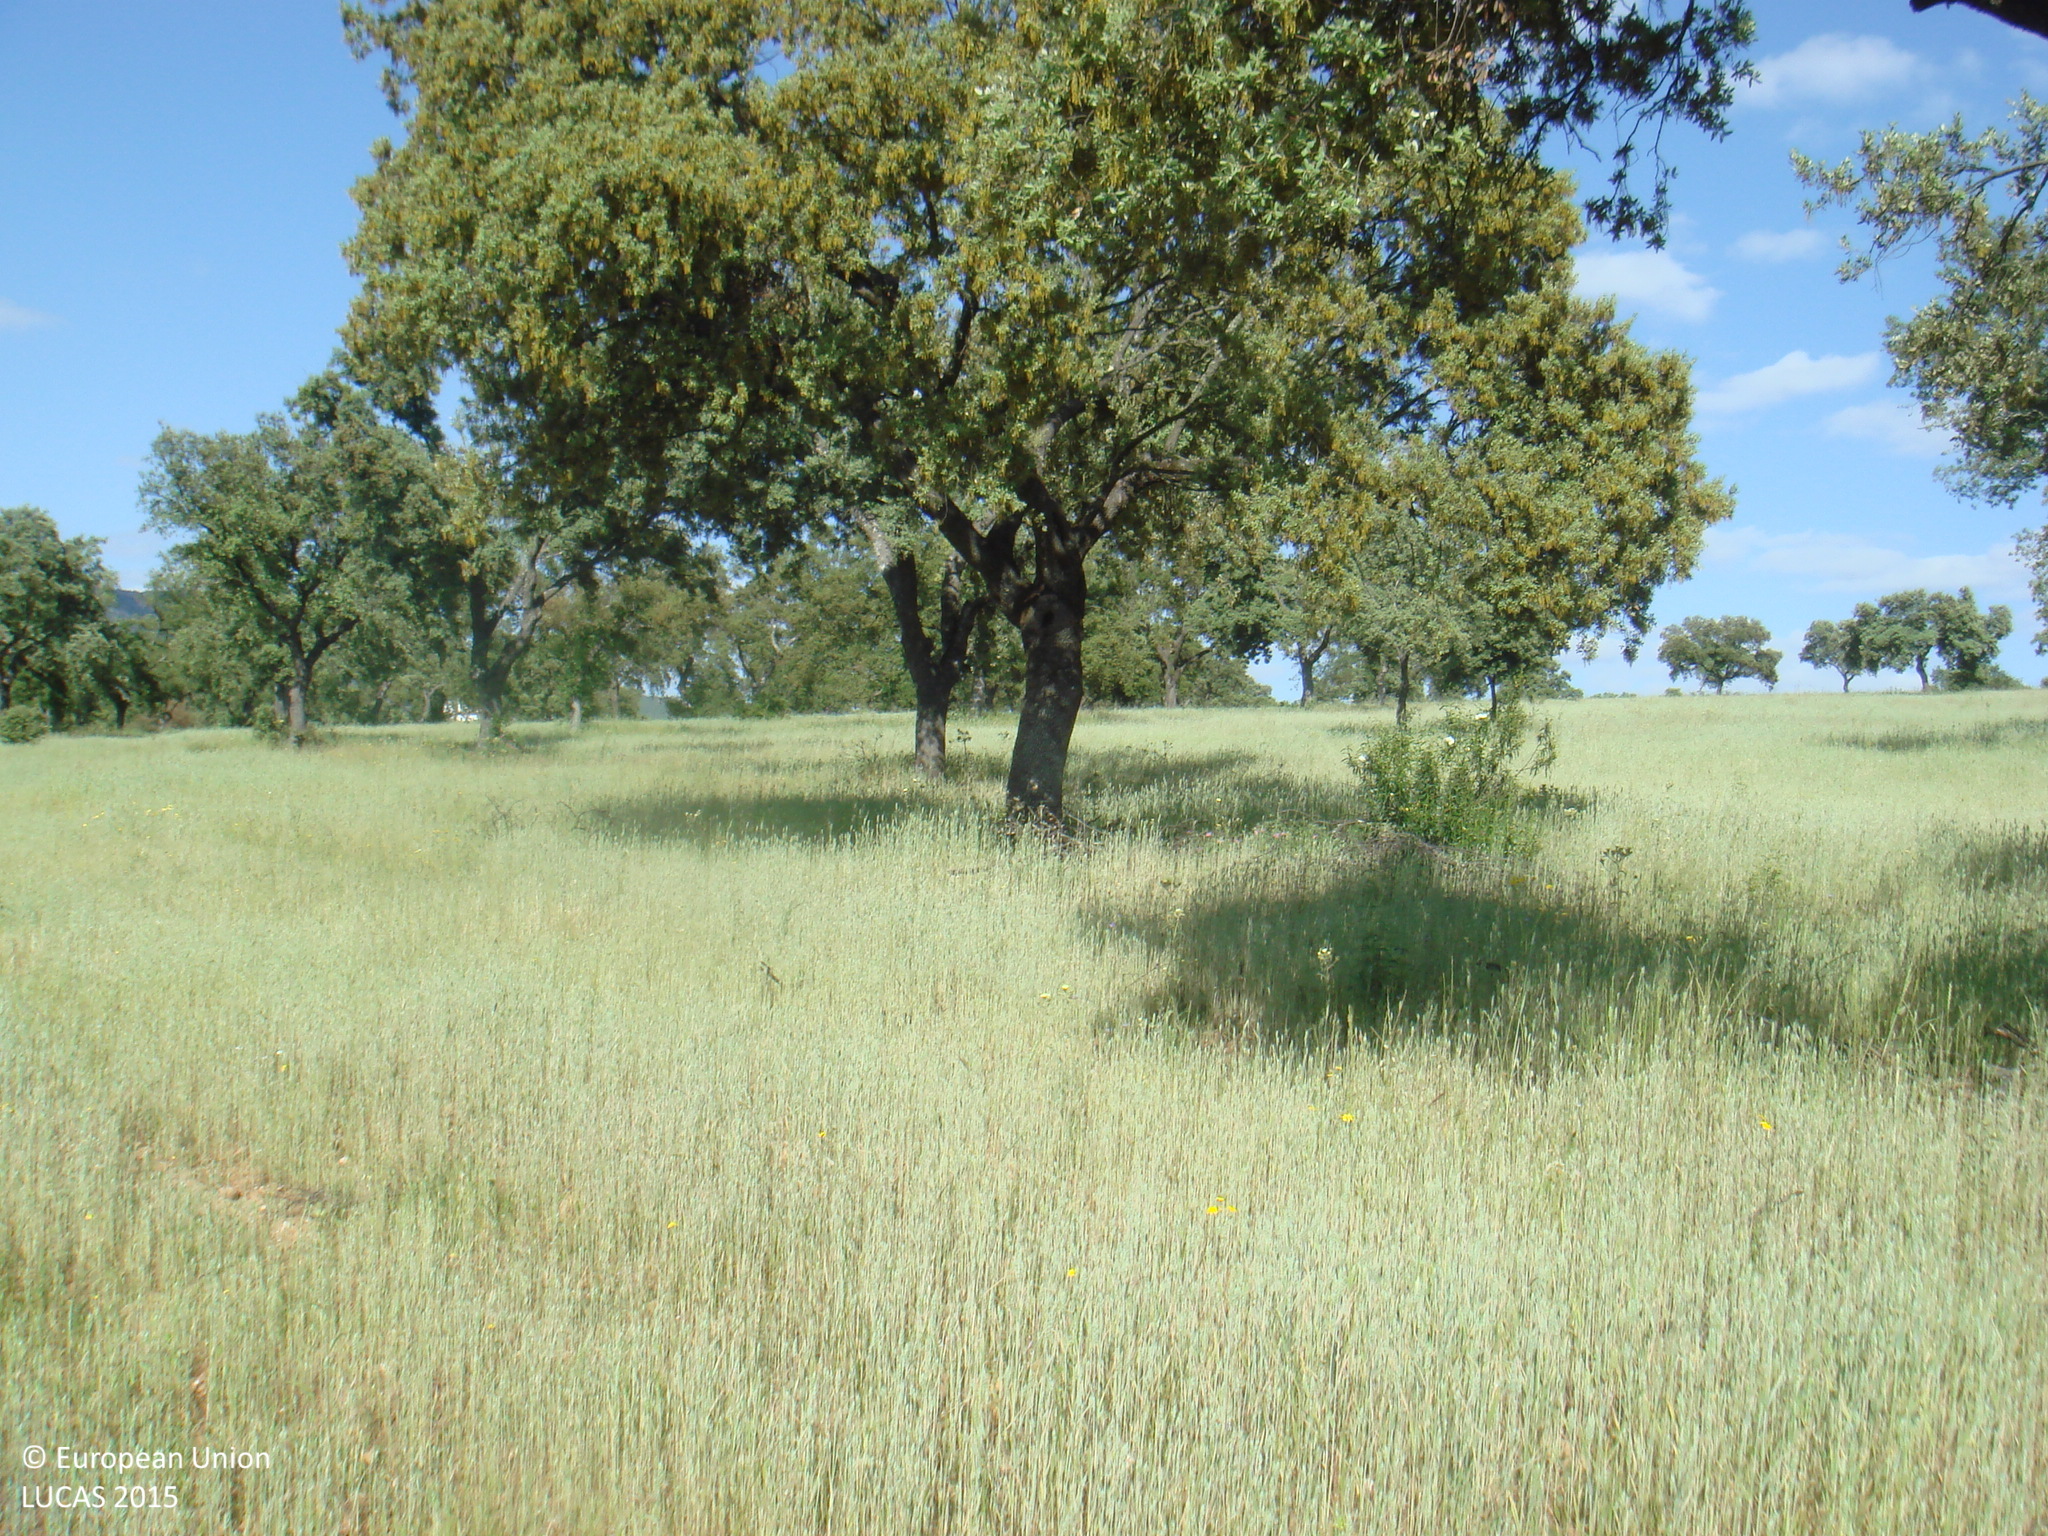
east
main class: Woodland
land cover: Broadleaved woodland
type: broadleaved evergreen forest
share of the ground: 50 - 75 %
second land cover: Common wheat
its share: > 75 %
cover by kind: herbaceous plants 60 %, broadleaved forest trees 40 %
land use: Forestry
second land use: Agriculture (excluding fallow land and kitchen gardens)
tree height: > 5 m
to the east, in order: Broadleaved woodland; Common wheat; Tracks; Broadleaved woodland; Common wheat
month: May
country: ES
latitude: 38.3966
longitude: -4.3640
